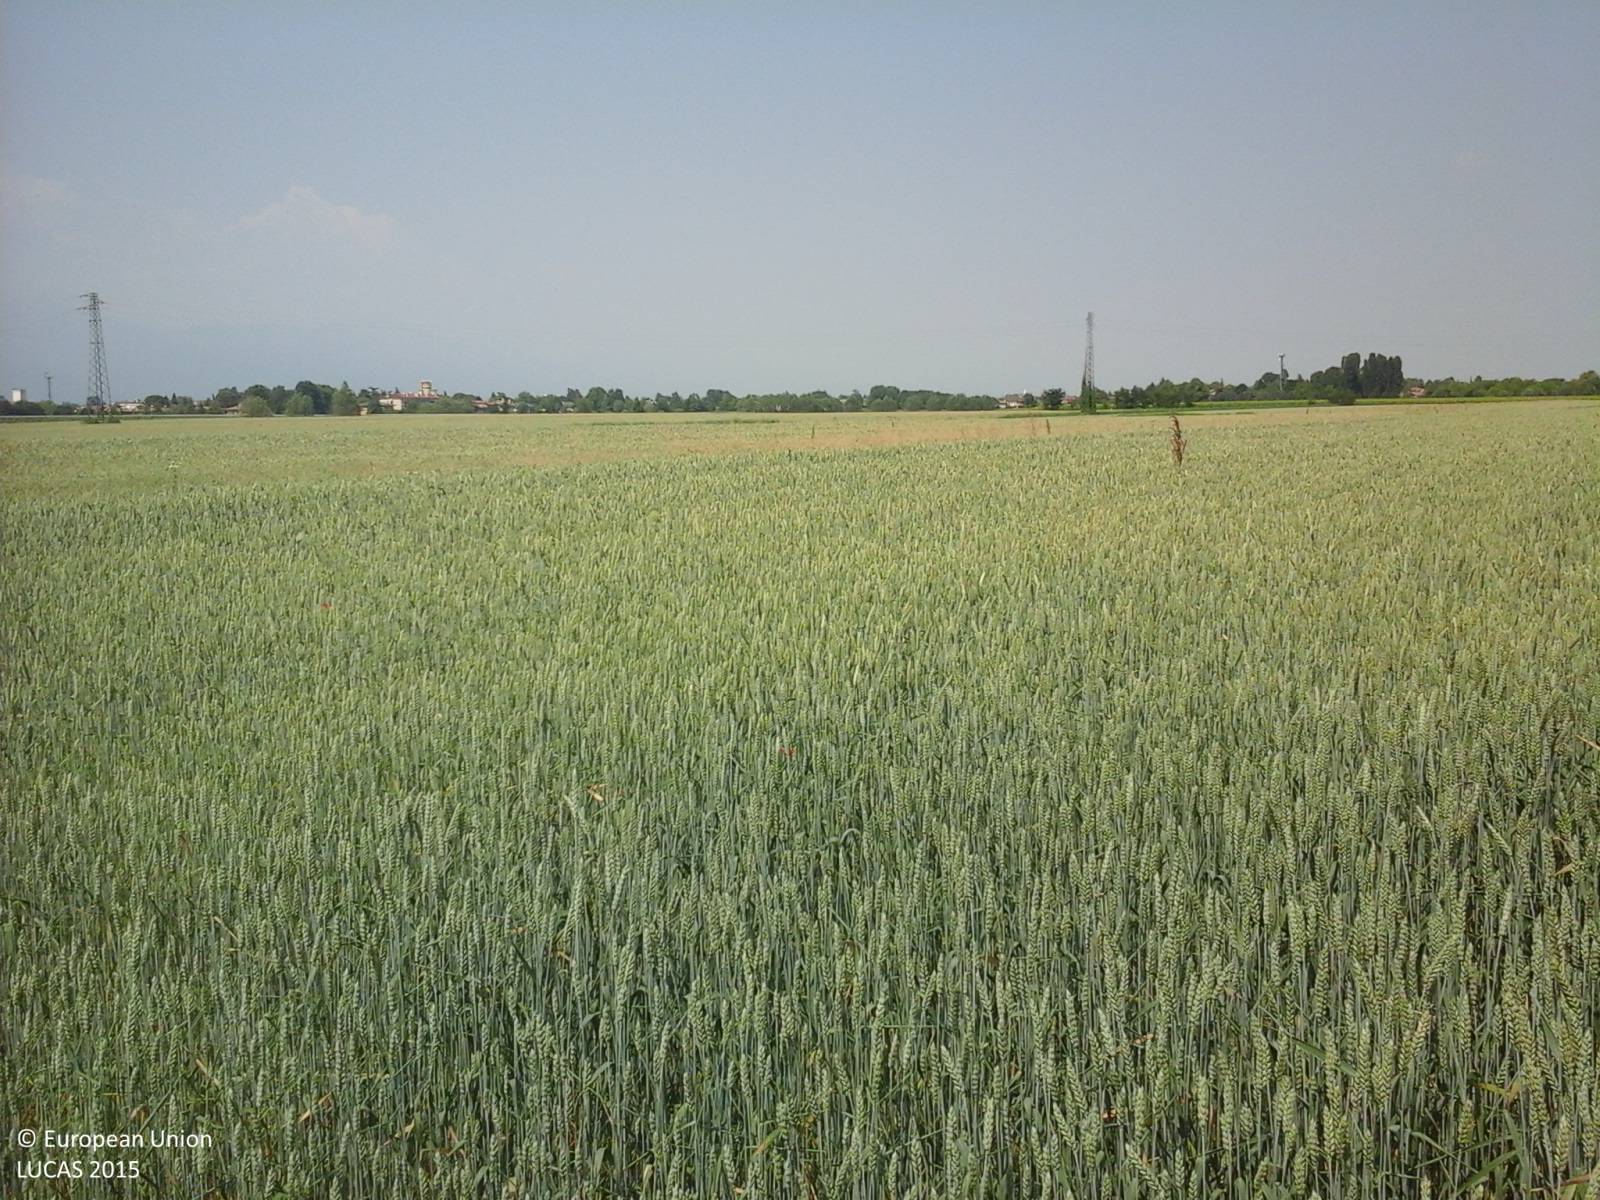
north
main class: Cropland
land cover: Common wheat
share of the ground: > 75 %
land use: Agriculture (excluding fallow land and kitchen gardens)
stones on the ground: < 10 %
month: June
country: IT
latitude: 45.8886
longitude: 12.5353
